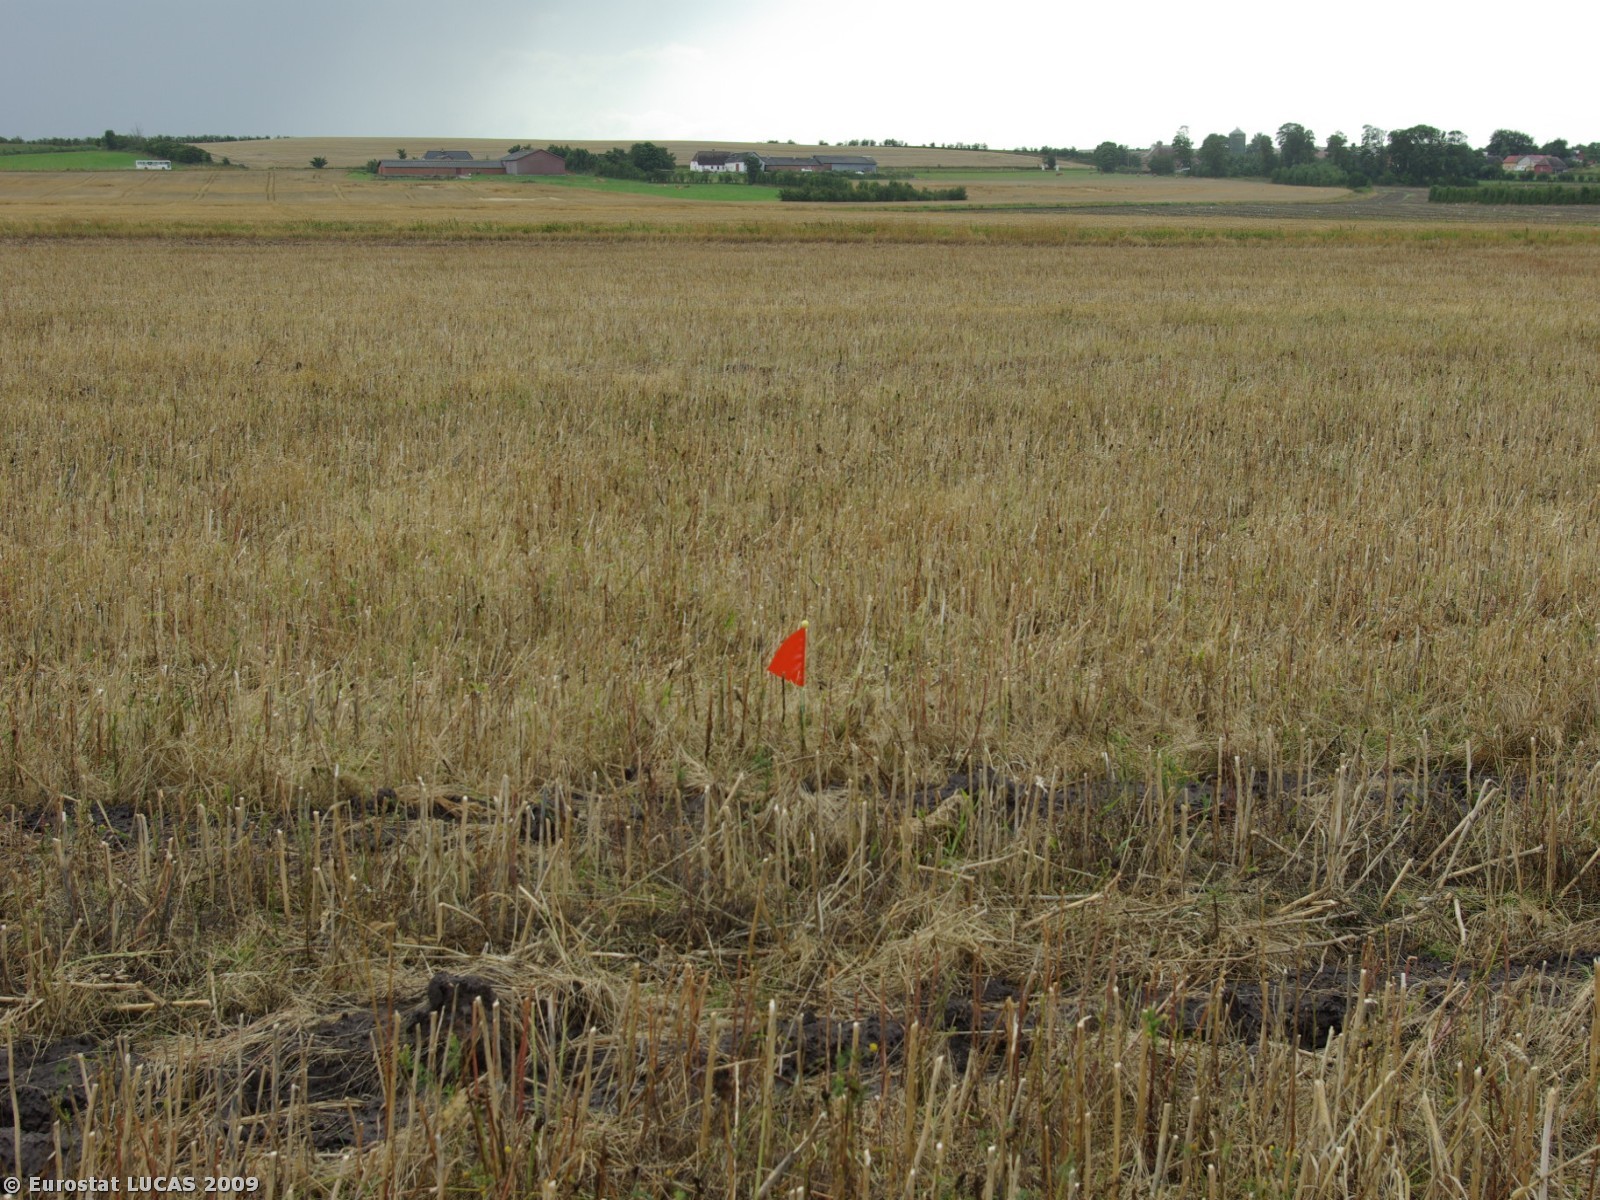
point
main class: Cropland
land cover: Rape and turnip rape
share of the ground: < 10 %
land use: Agriculture (excluding fallow land and kitchen gardens)
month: July
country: DK
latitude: 55.2312
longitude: 9.0103
